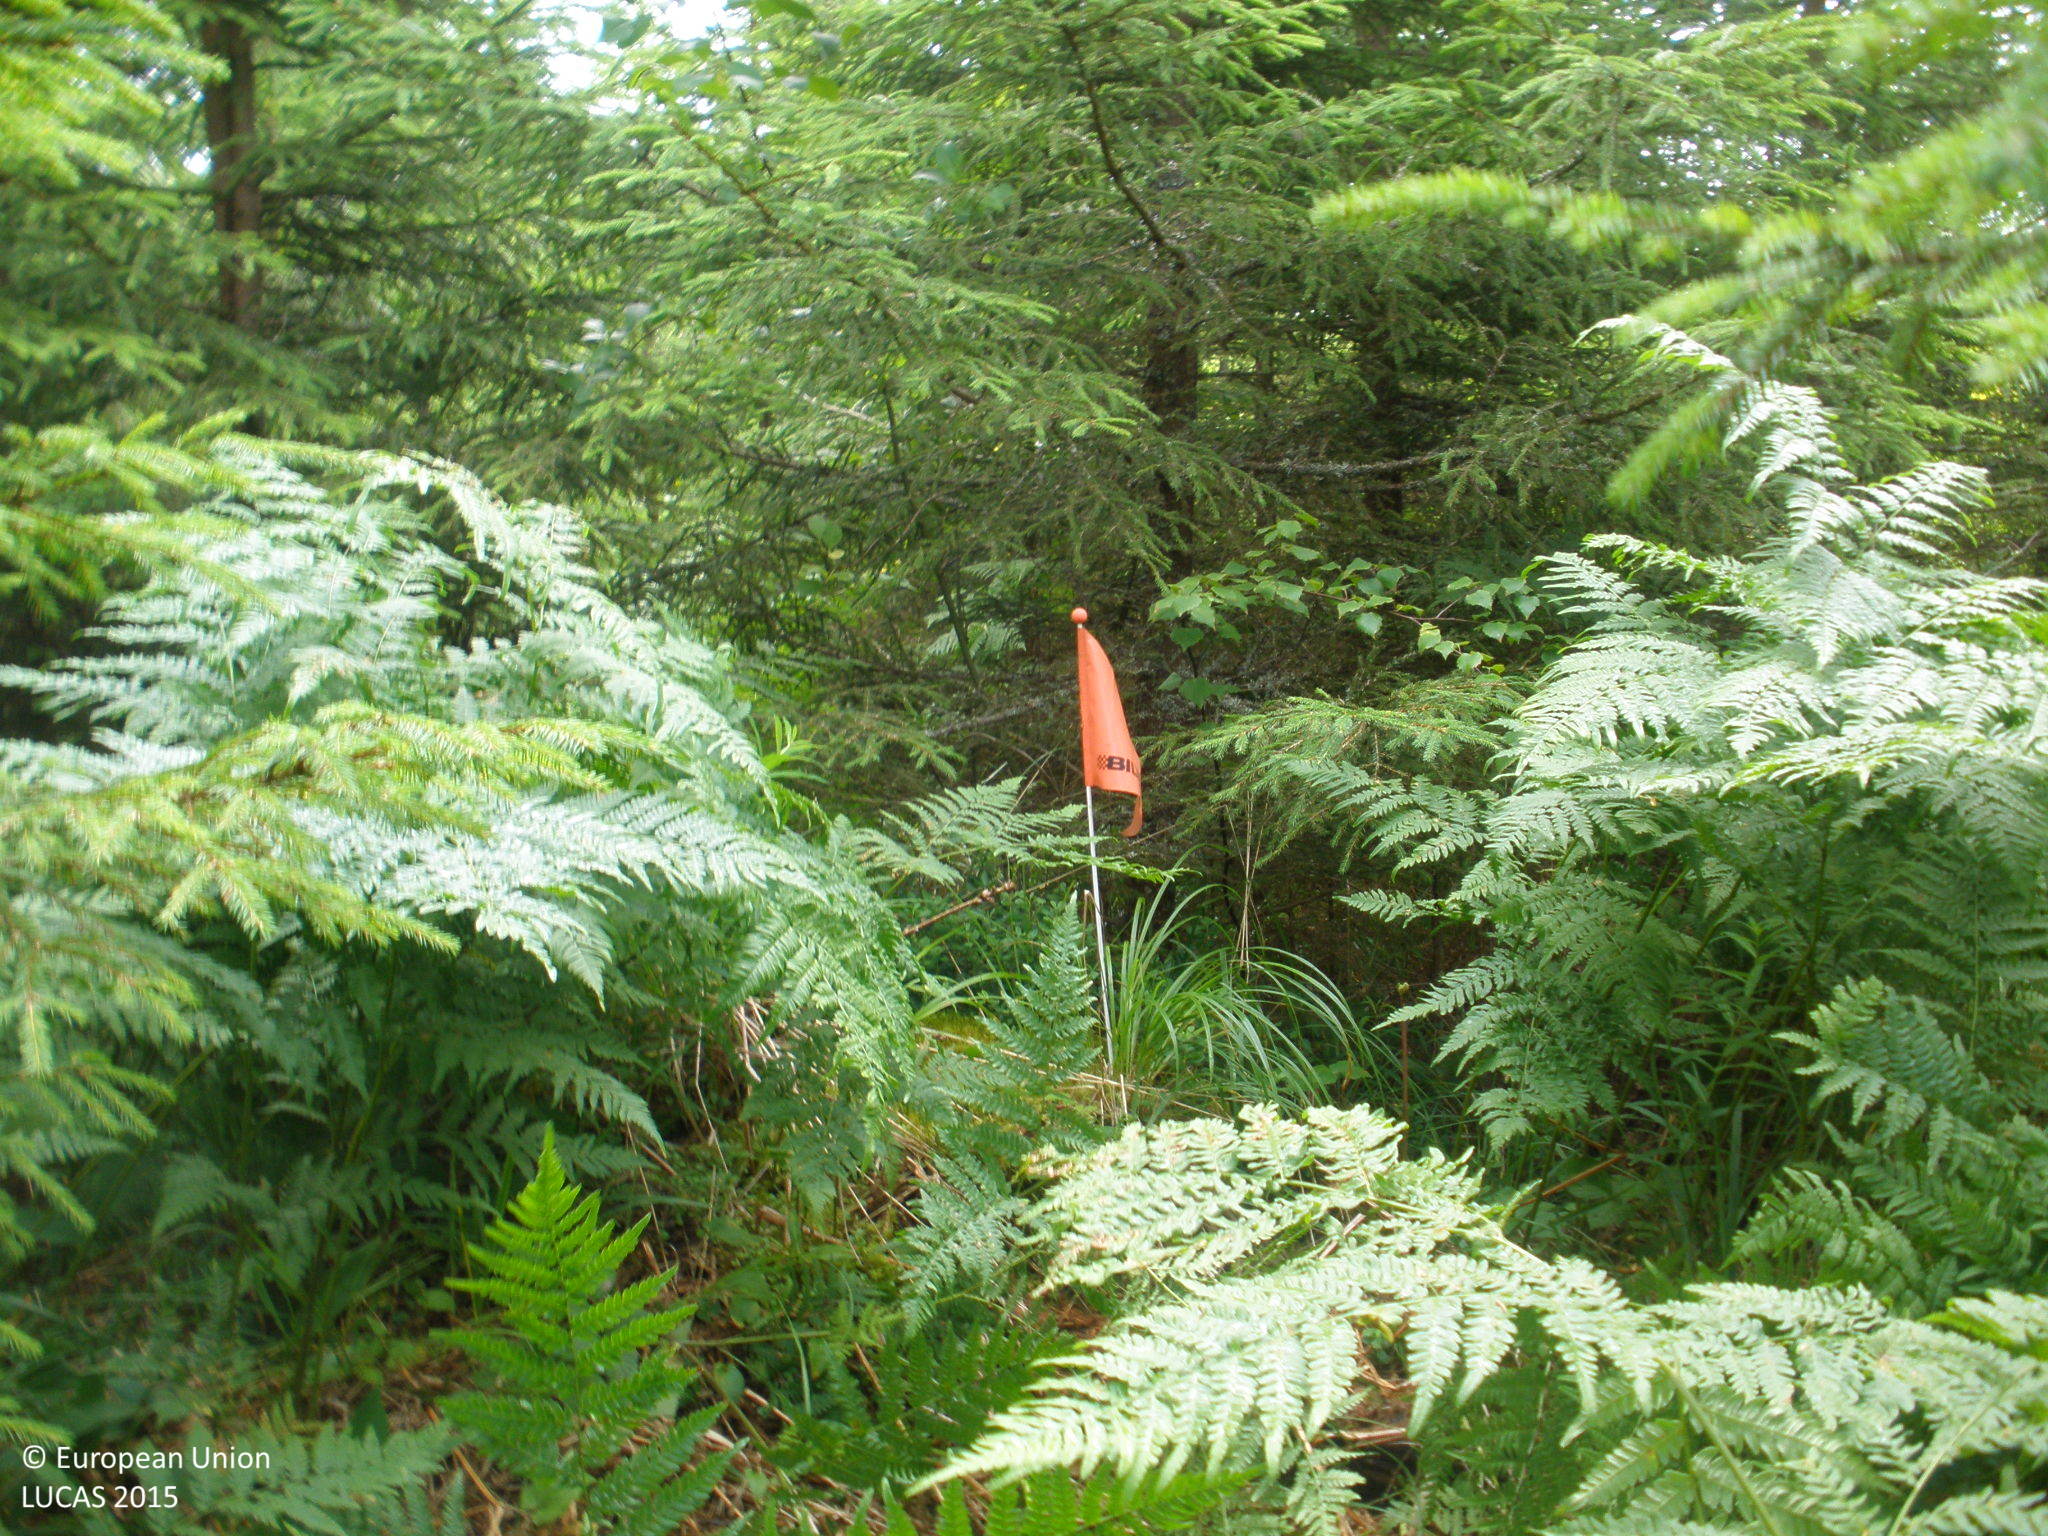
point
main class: Woodland
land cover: Spruce dominated coniferous woodland
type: boreal forest
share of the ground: > 75 %
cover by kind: coniferous forest trees 70 %, broadleaved forest trees 10 %, shrubs 10 %, herbaceous plants 10 %
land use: Forestry
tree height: > 5 m
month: July
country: FI
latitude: 61.2271
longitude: 24.8396
